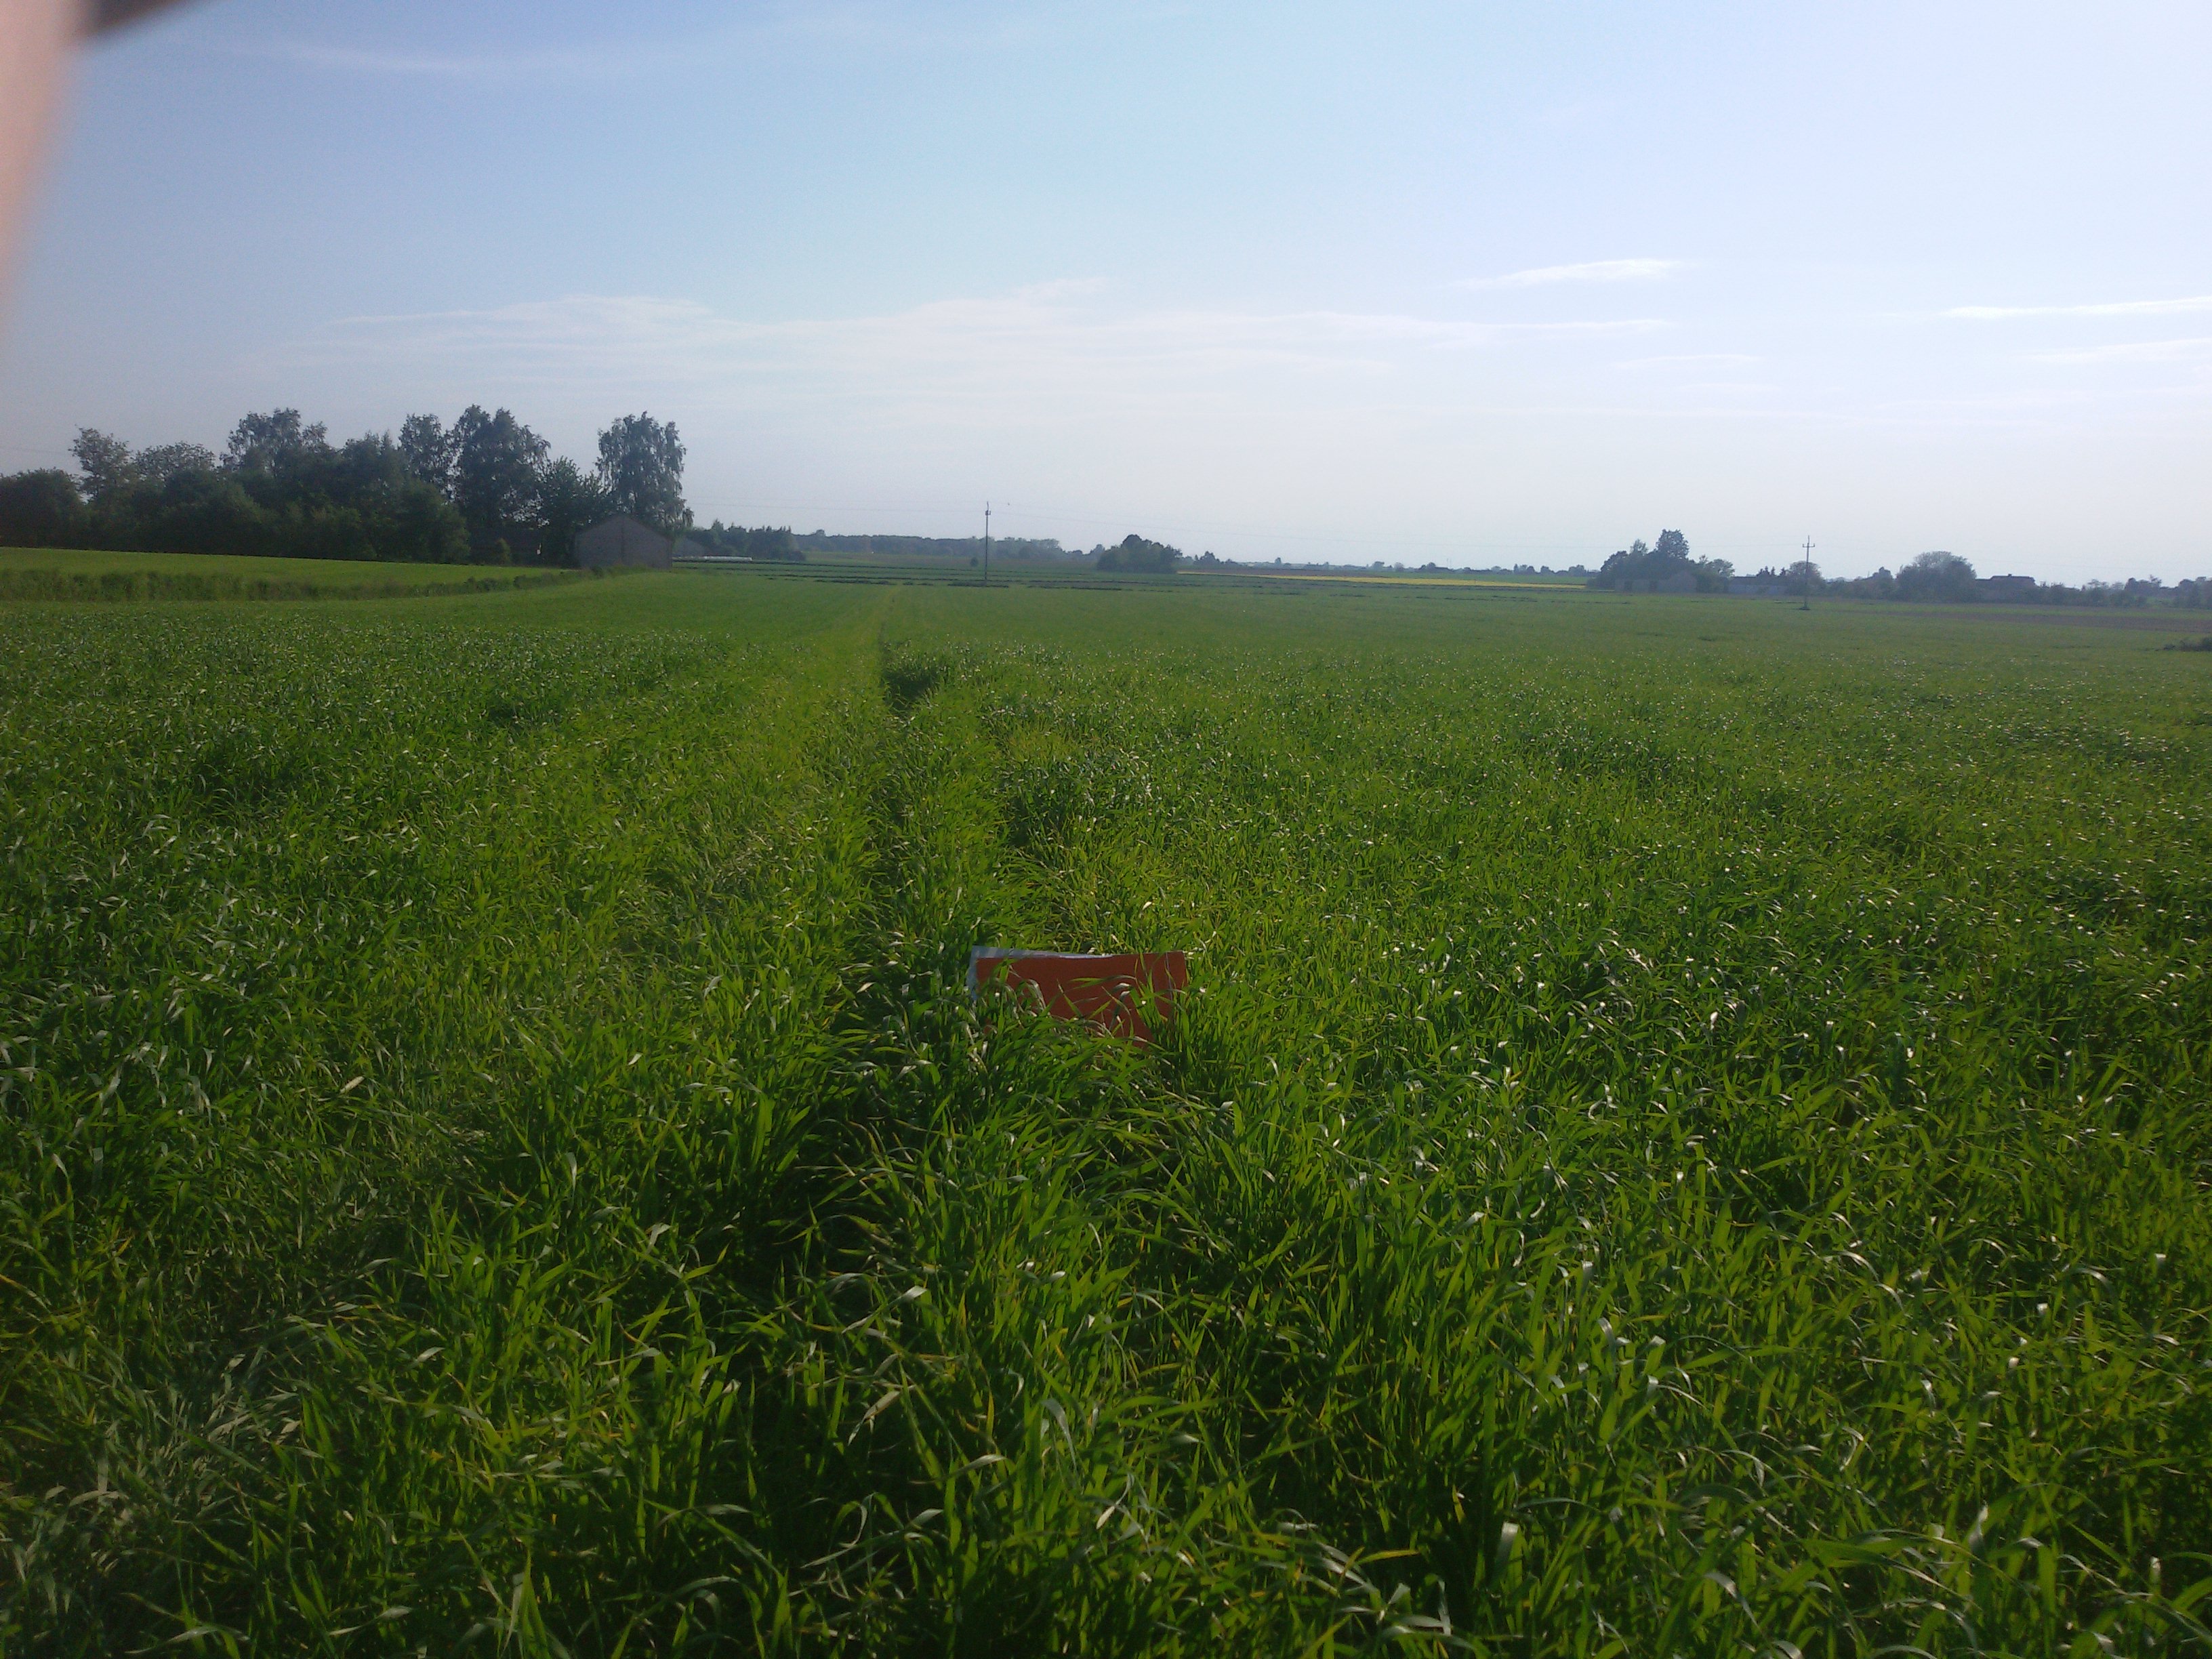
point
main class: Cropland
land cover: Common wheat
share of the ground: > 75 %
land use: Agriculture (excluding fallow land and kitchen gardens)
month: May
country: PL
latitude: 51.2513
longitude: 22.8962
